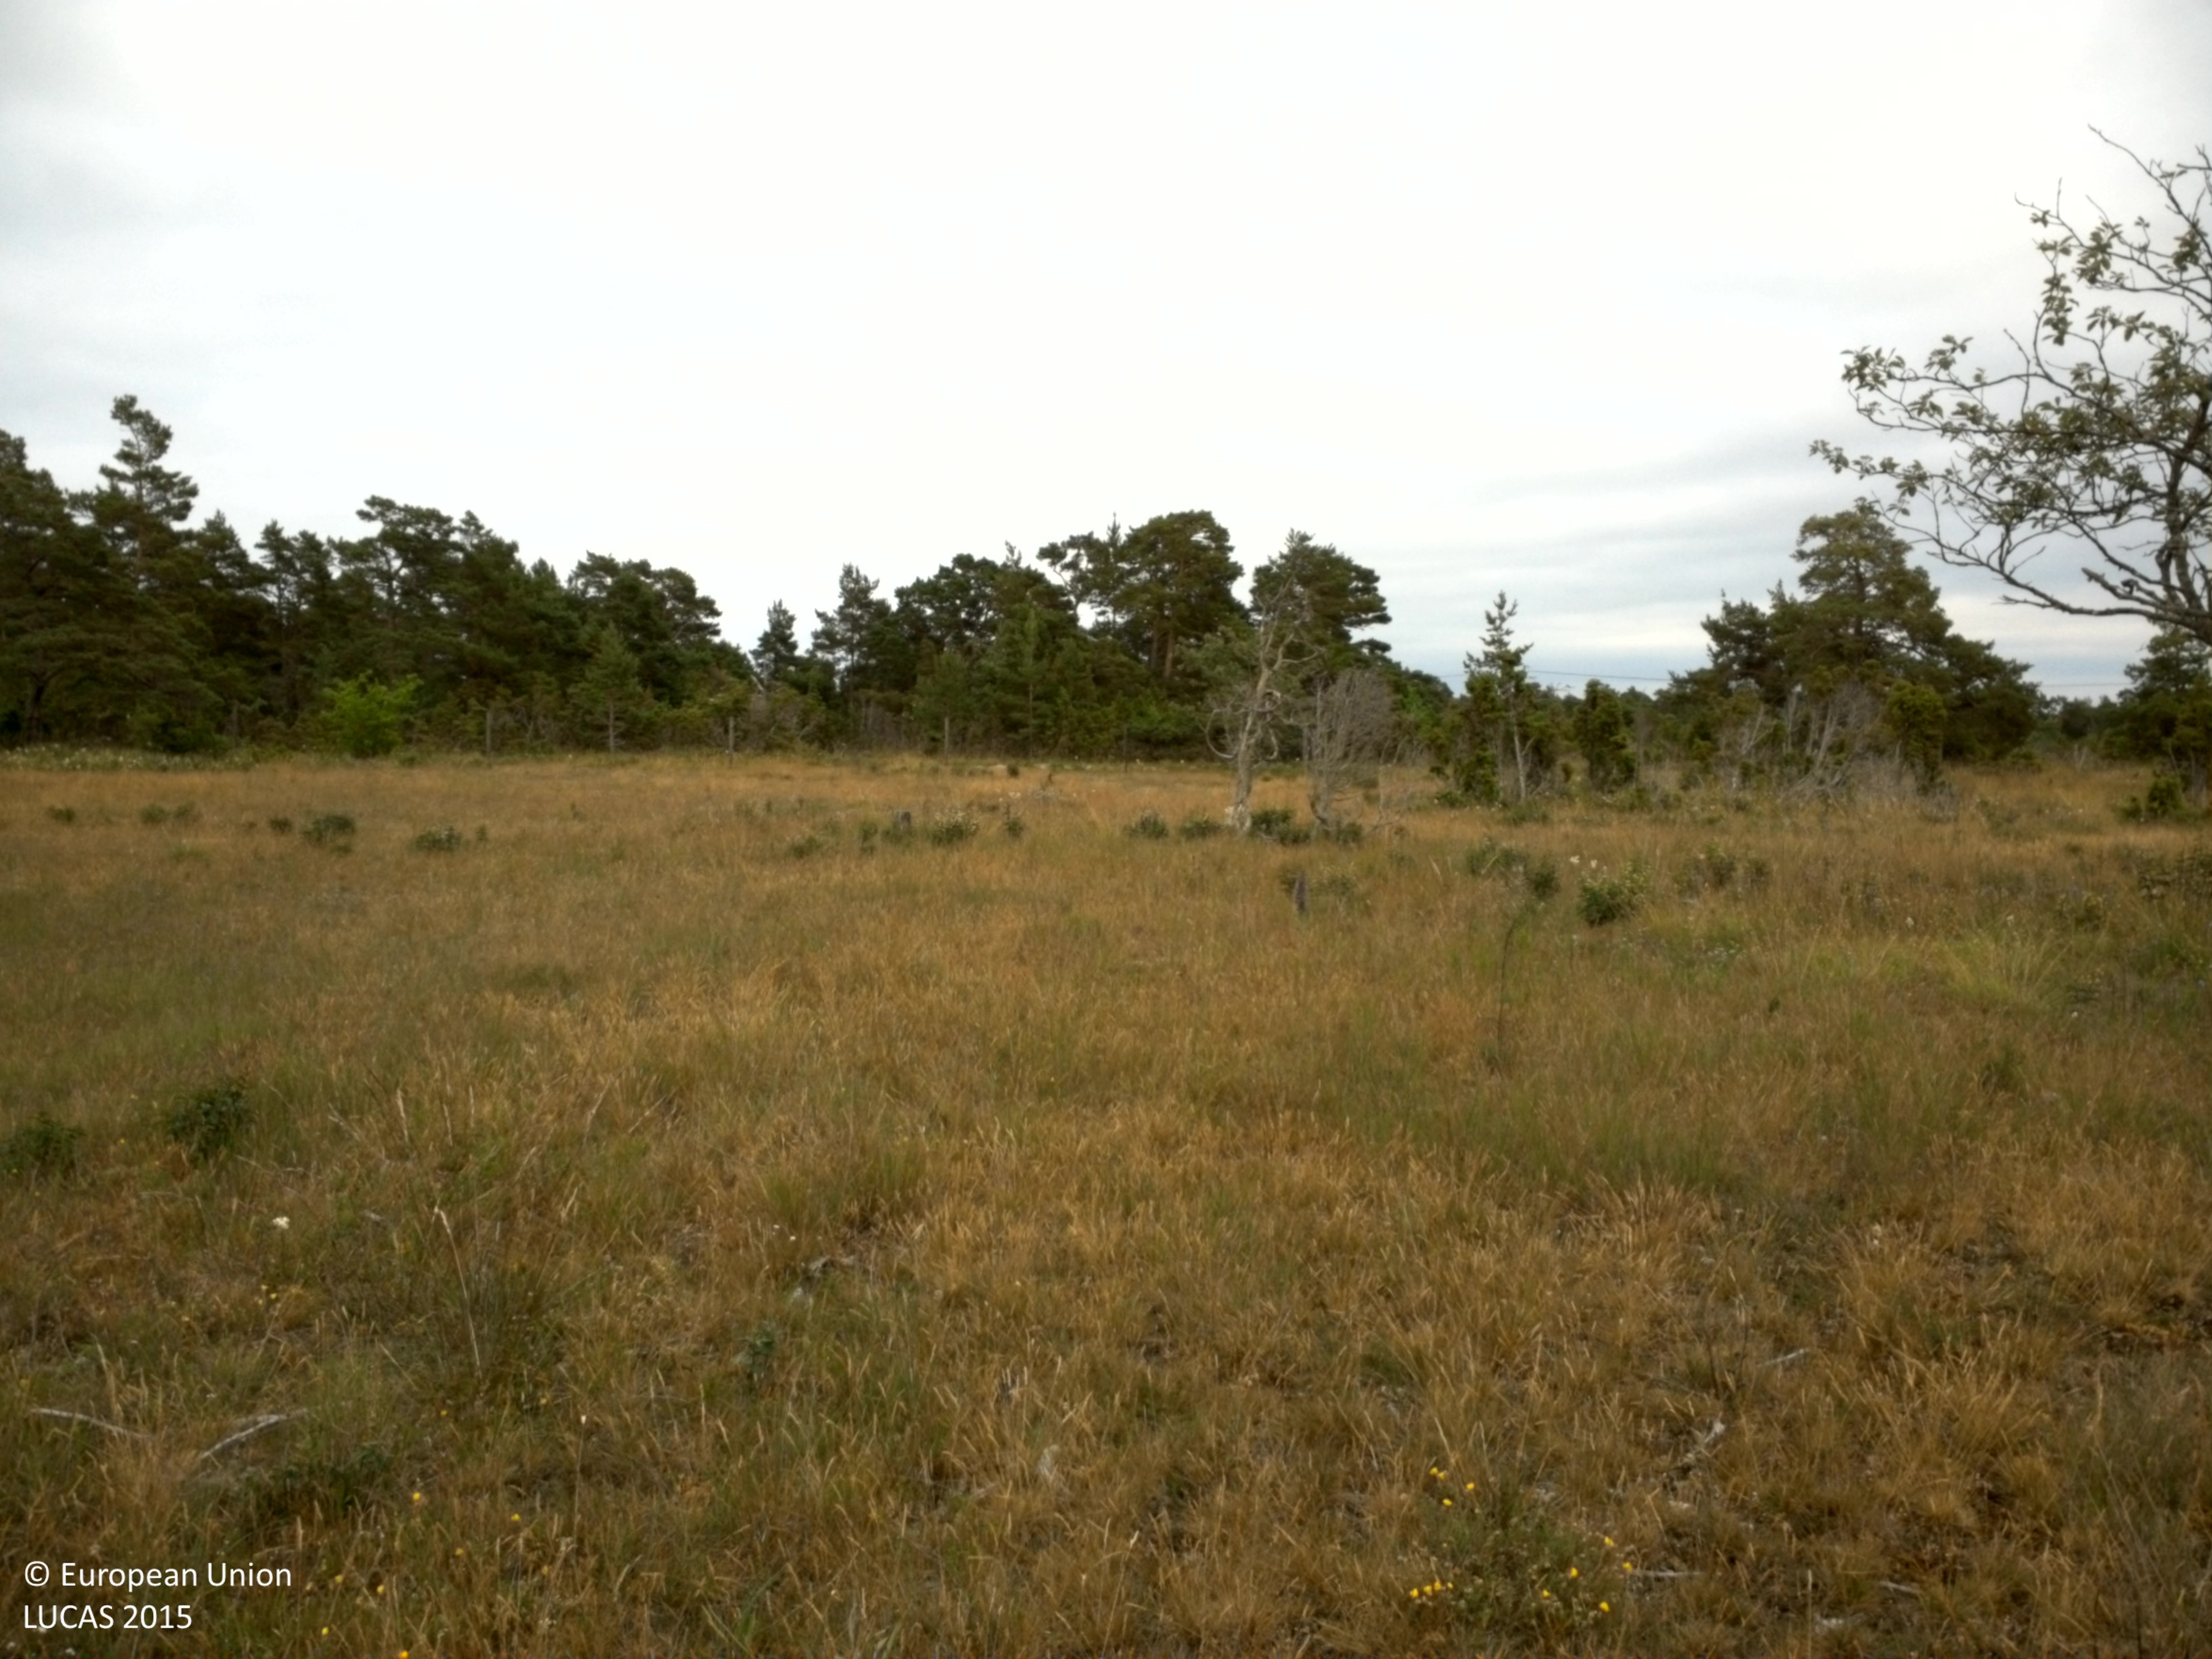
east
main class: Grassland
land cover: Grassland with sparse tree/shrub cover
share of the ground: > 75 %
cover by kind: herbaceous plants 85 %, coniferous forest trees 5 %, shrubs 5 %, lichens and mosses 5 %
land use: Agriculture (excluding fallow land and kitchen gardens)
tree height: > 5 m
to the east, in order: Grassland with sparse tree/shrub cover; Fences; Grass margins; Paved roads, cycling and walking lanes; Pine dominated coniferous woodland; Shrubland with sparse tree cover; Pine dominated coniferous woodland; Shrubland with sparse tree cover; Electric lines; Grass margins; Paved roads, cycling and walking lanes; Grass margins; Pine dominated coniferous woodland; Shrubland with sparse tree cover
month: June
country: SE
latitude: 57.9056
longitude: 18.9029
